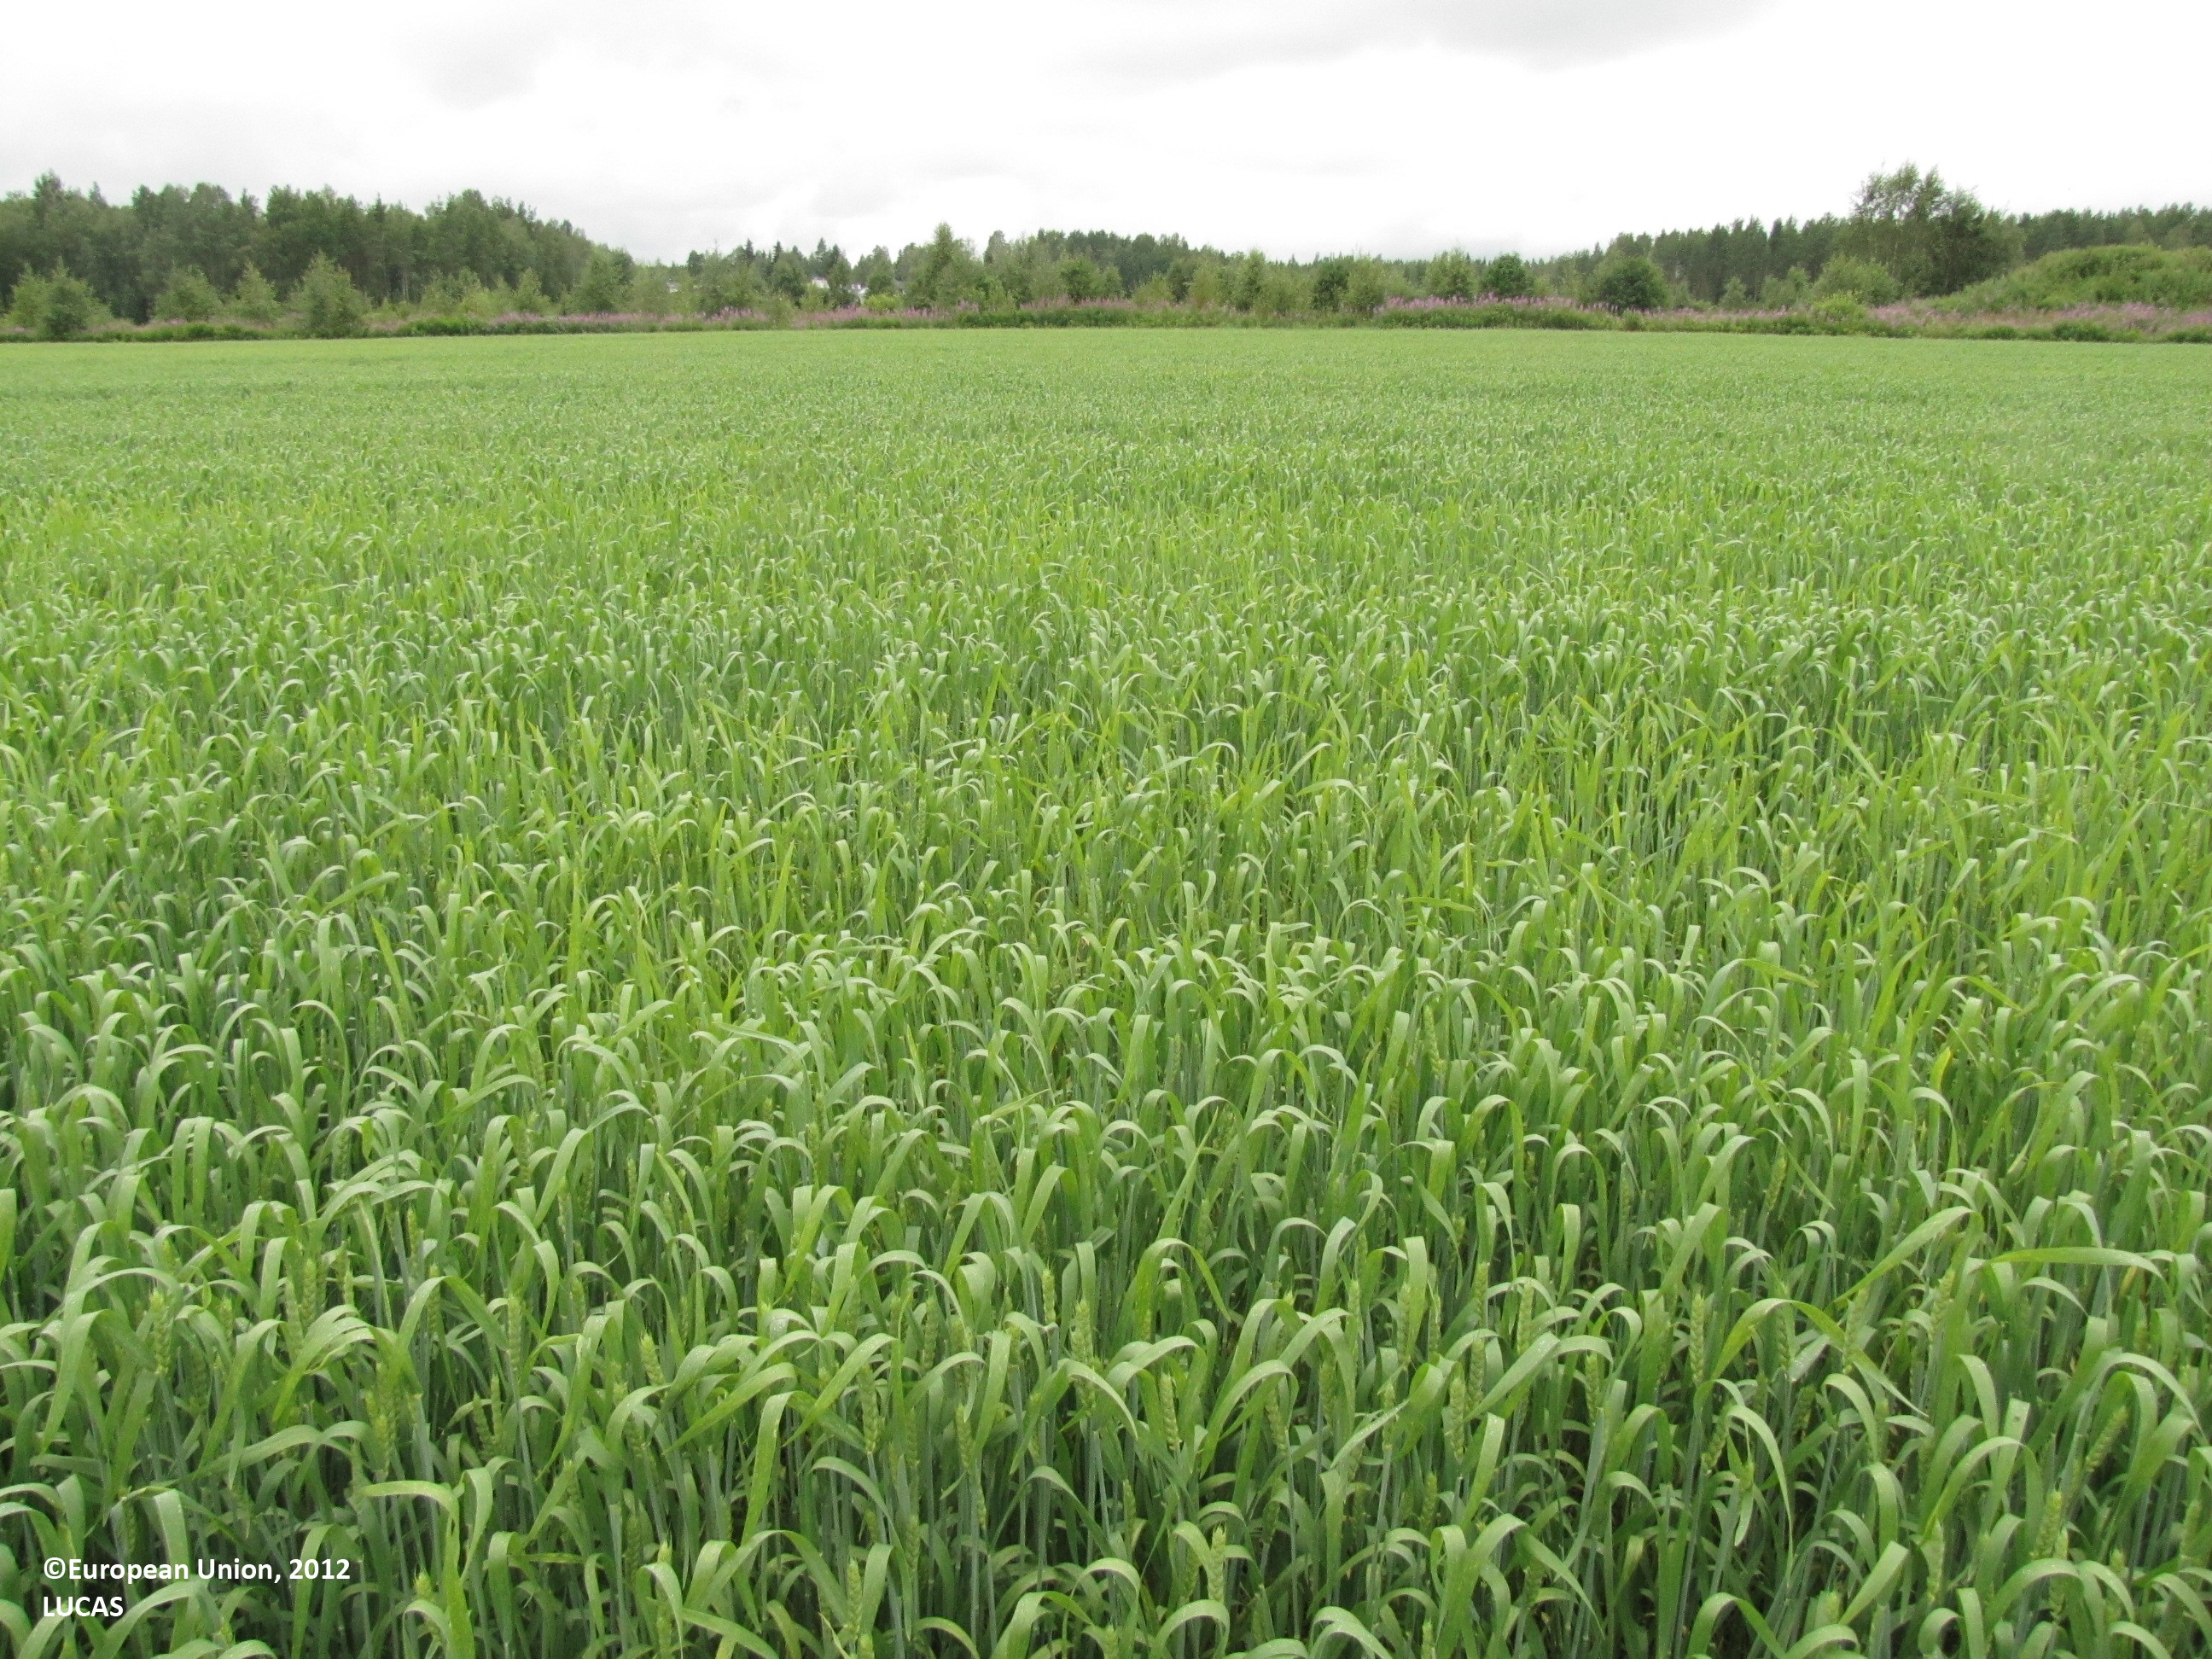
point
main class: Cropland
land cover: Common wheat
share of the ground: > 75 %
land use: Agriculture (excluding fallow land and kitchen gardens)
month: July
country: FI
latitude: 62.4851
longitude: 23.0049
